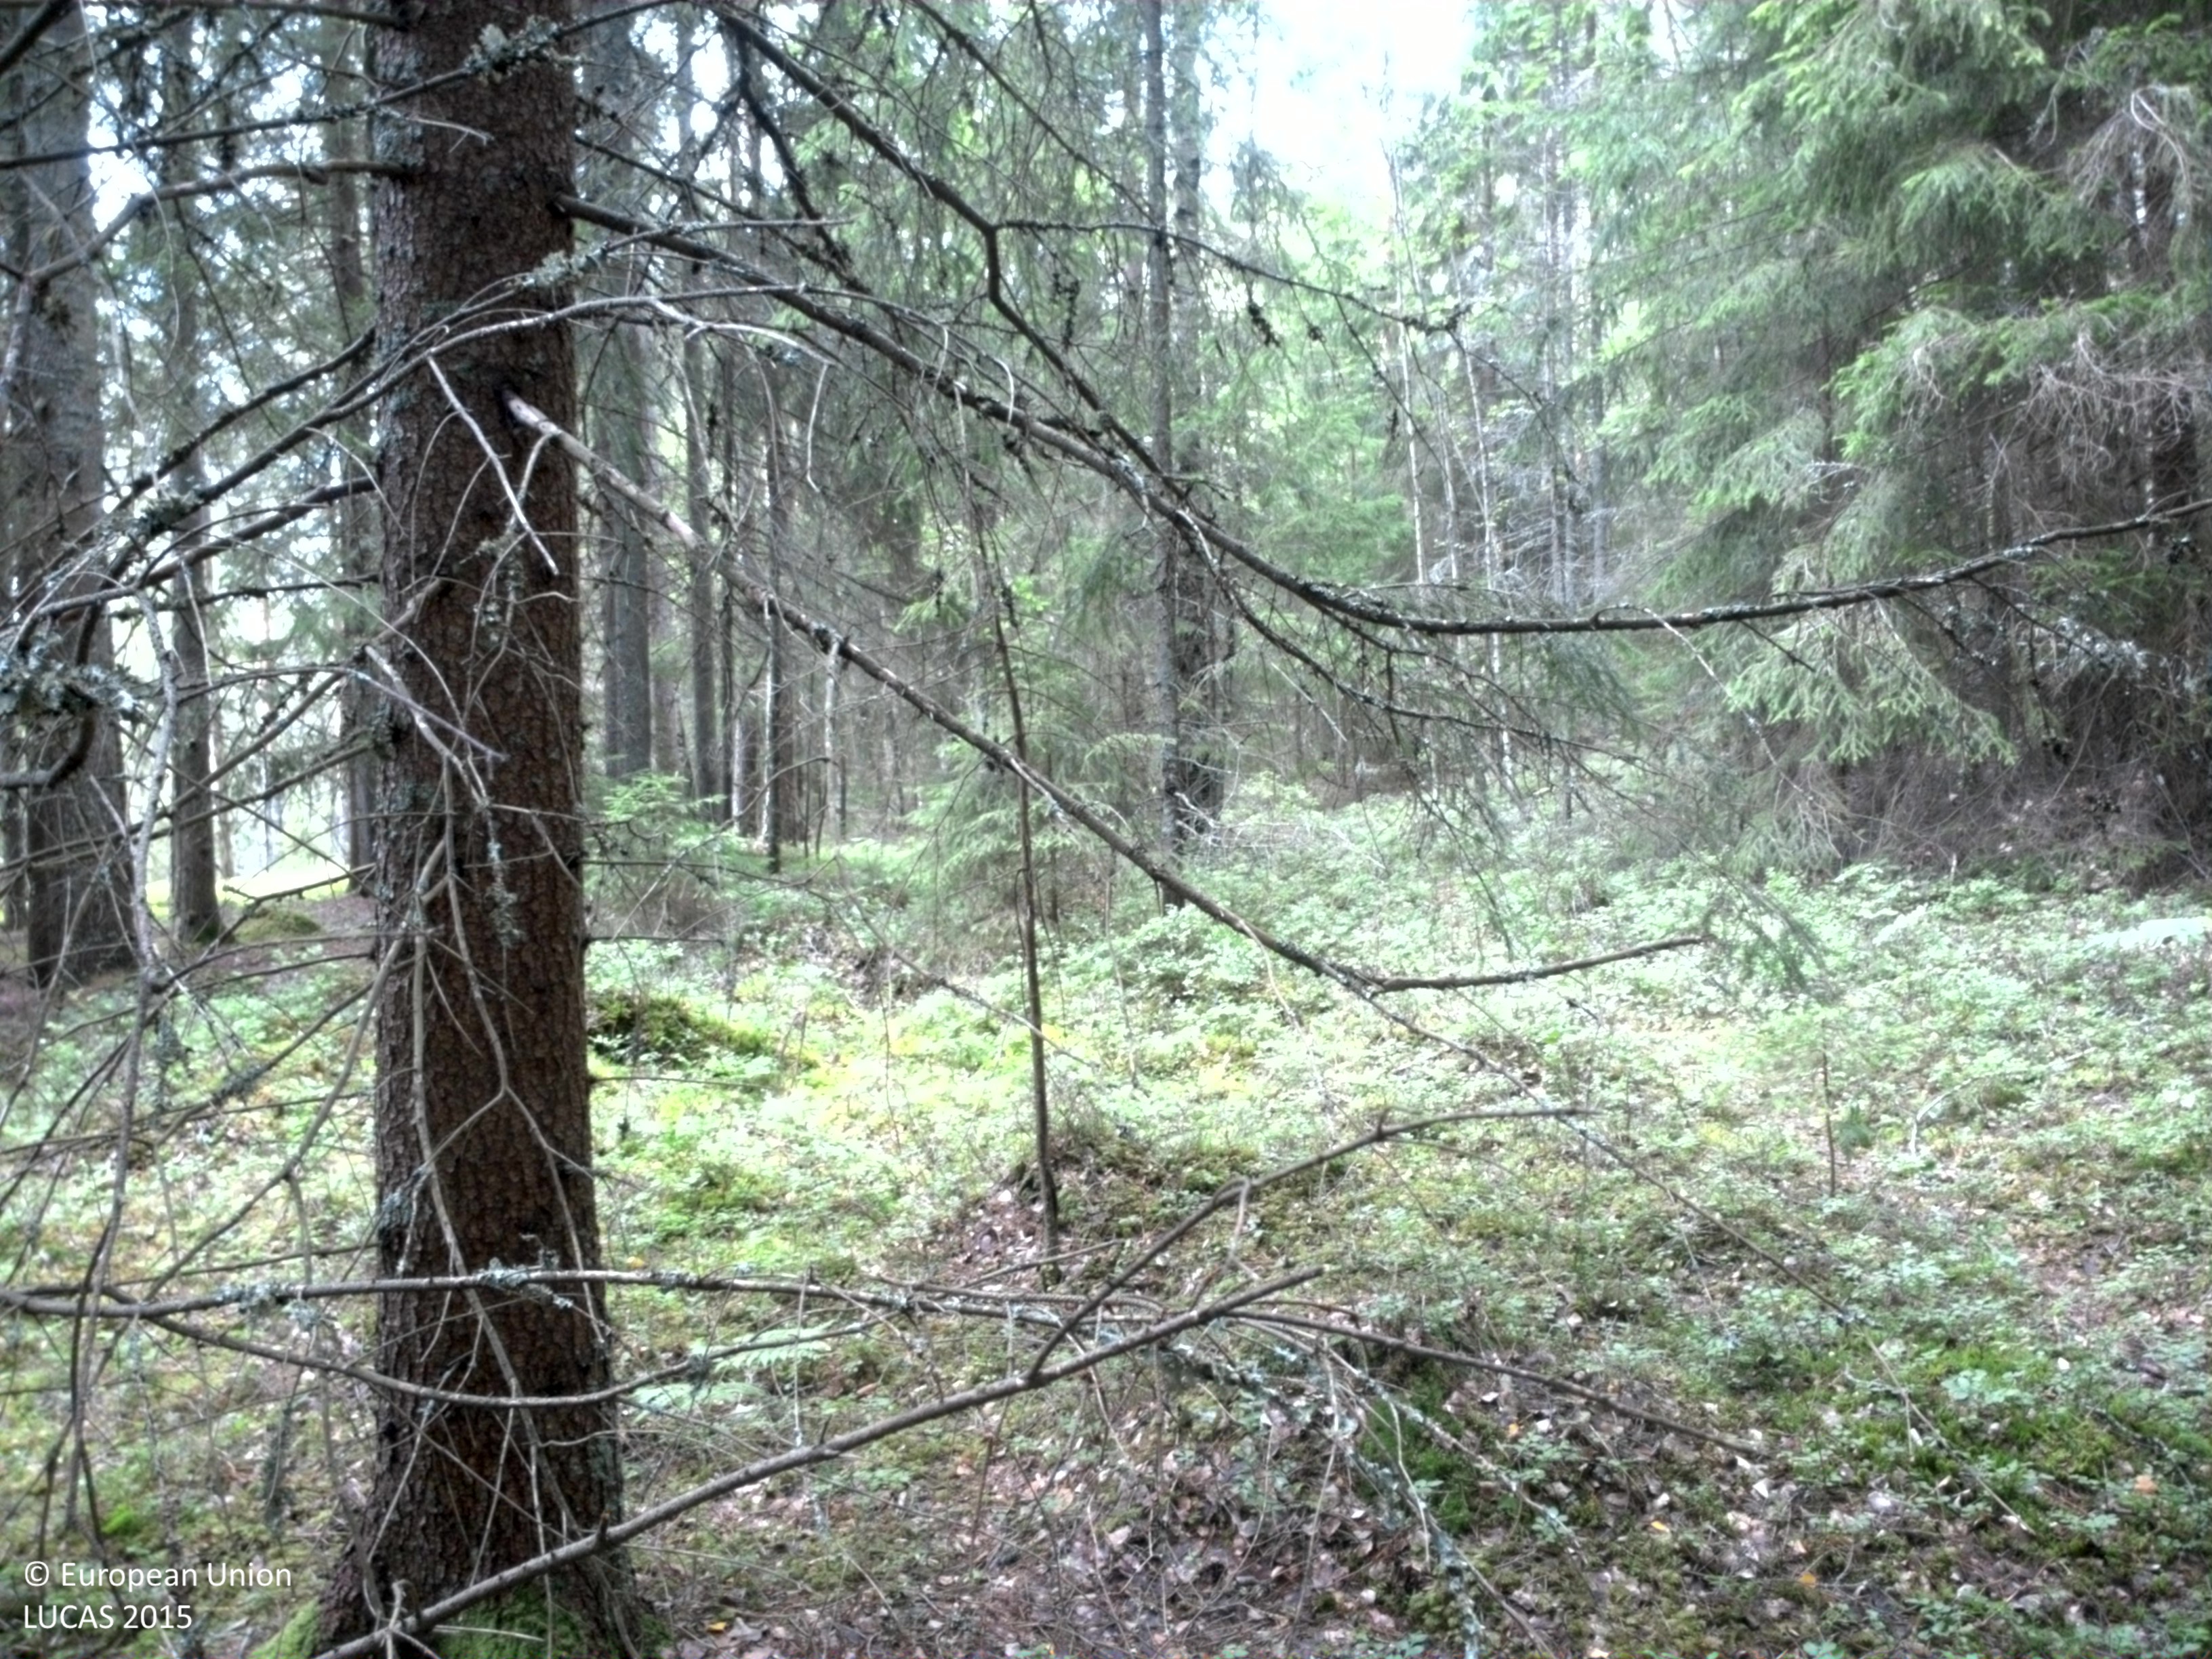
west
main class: Woodland
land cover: Spruce dominated mixed woodland
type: boreal forest
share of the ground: 50 - 75 %
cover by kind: coniferous forest trees 55 %, broadleaved forest trees 20 %, shrubs 15 %, lichens and mosses 10 %
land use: Forestry
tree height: > 5 m
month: July
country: SE
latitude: 59.4120
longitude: 11.8803
